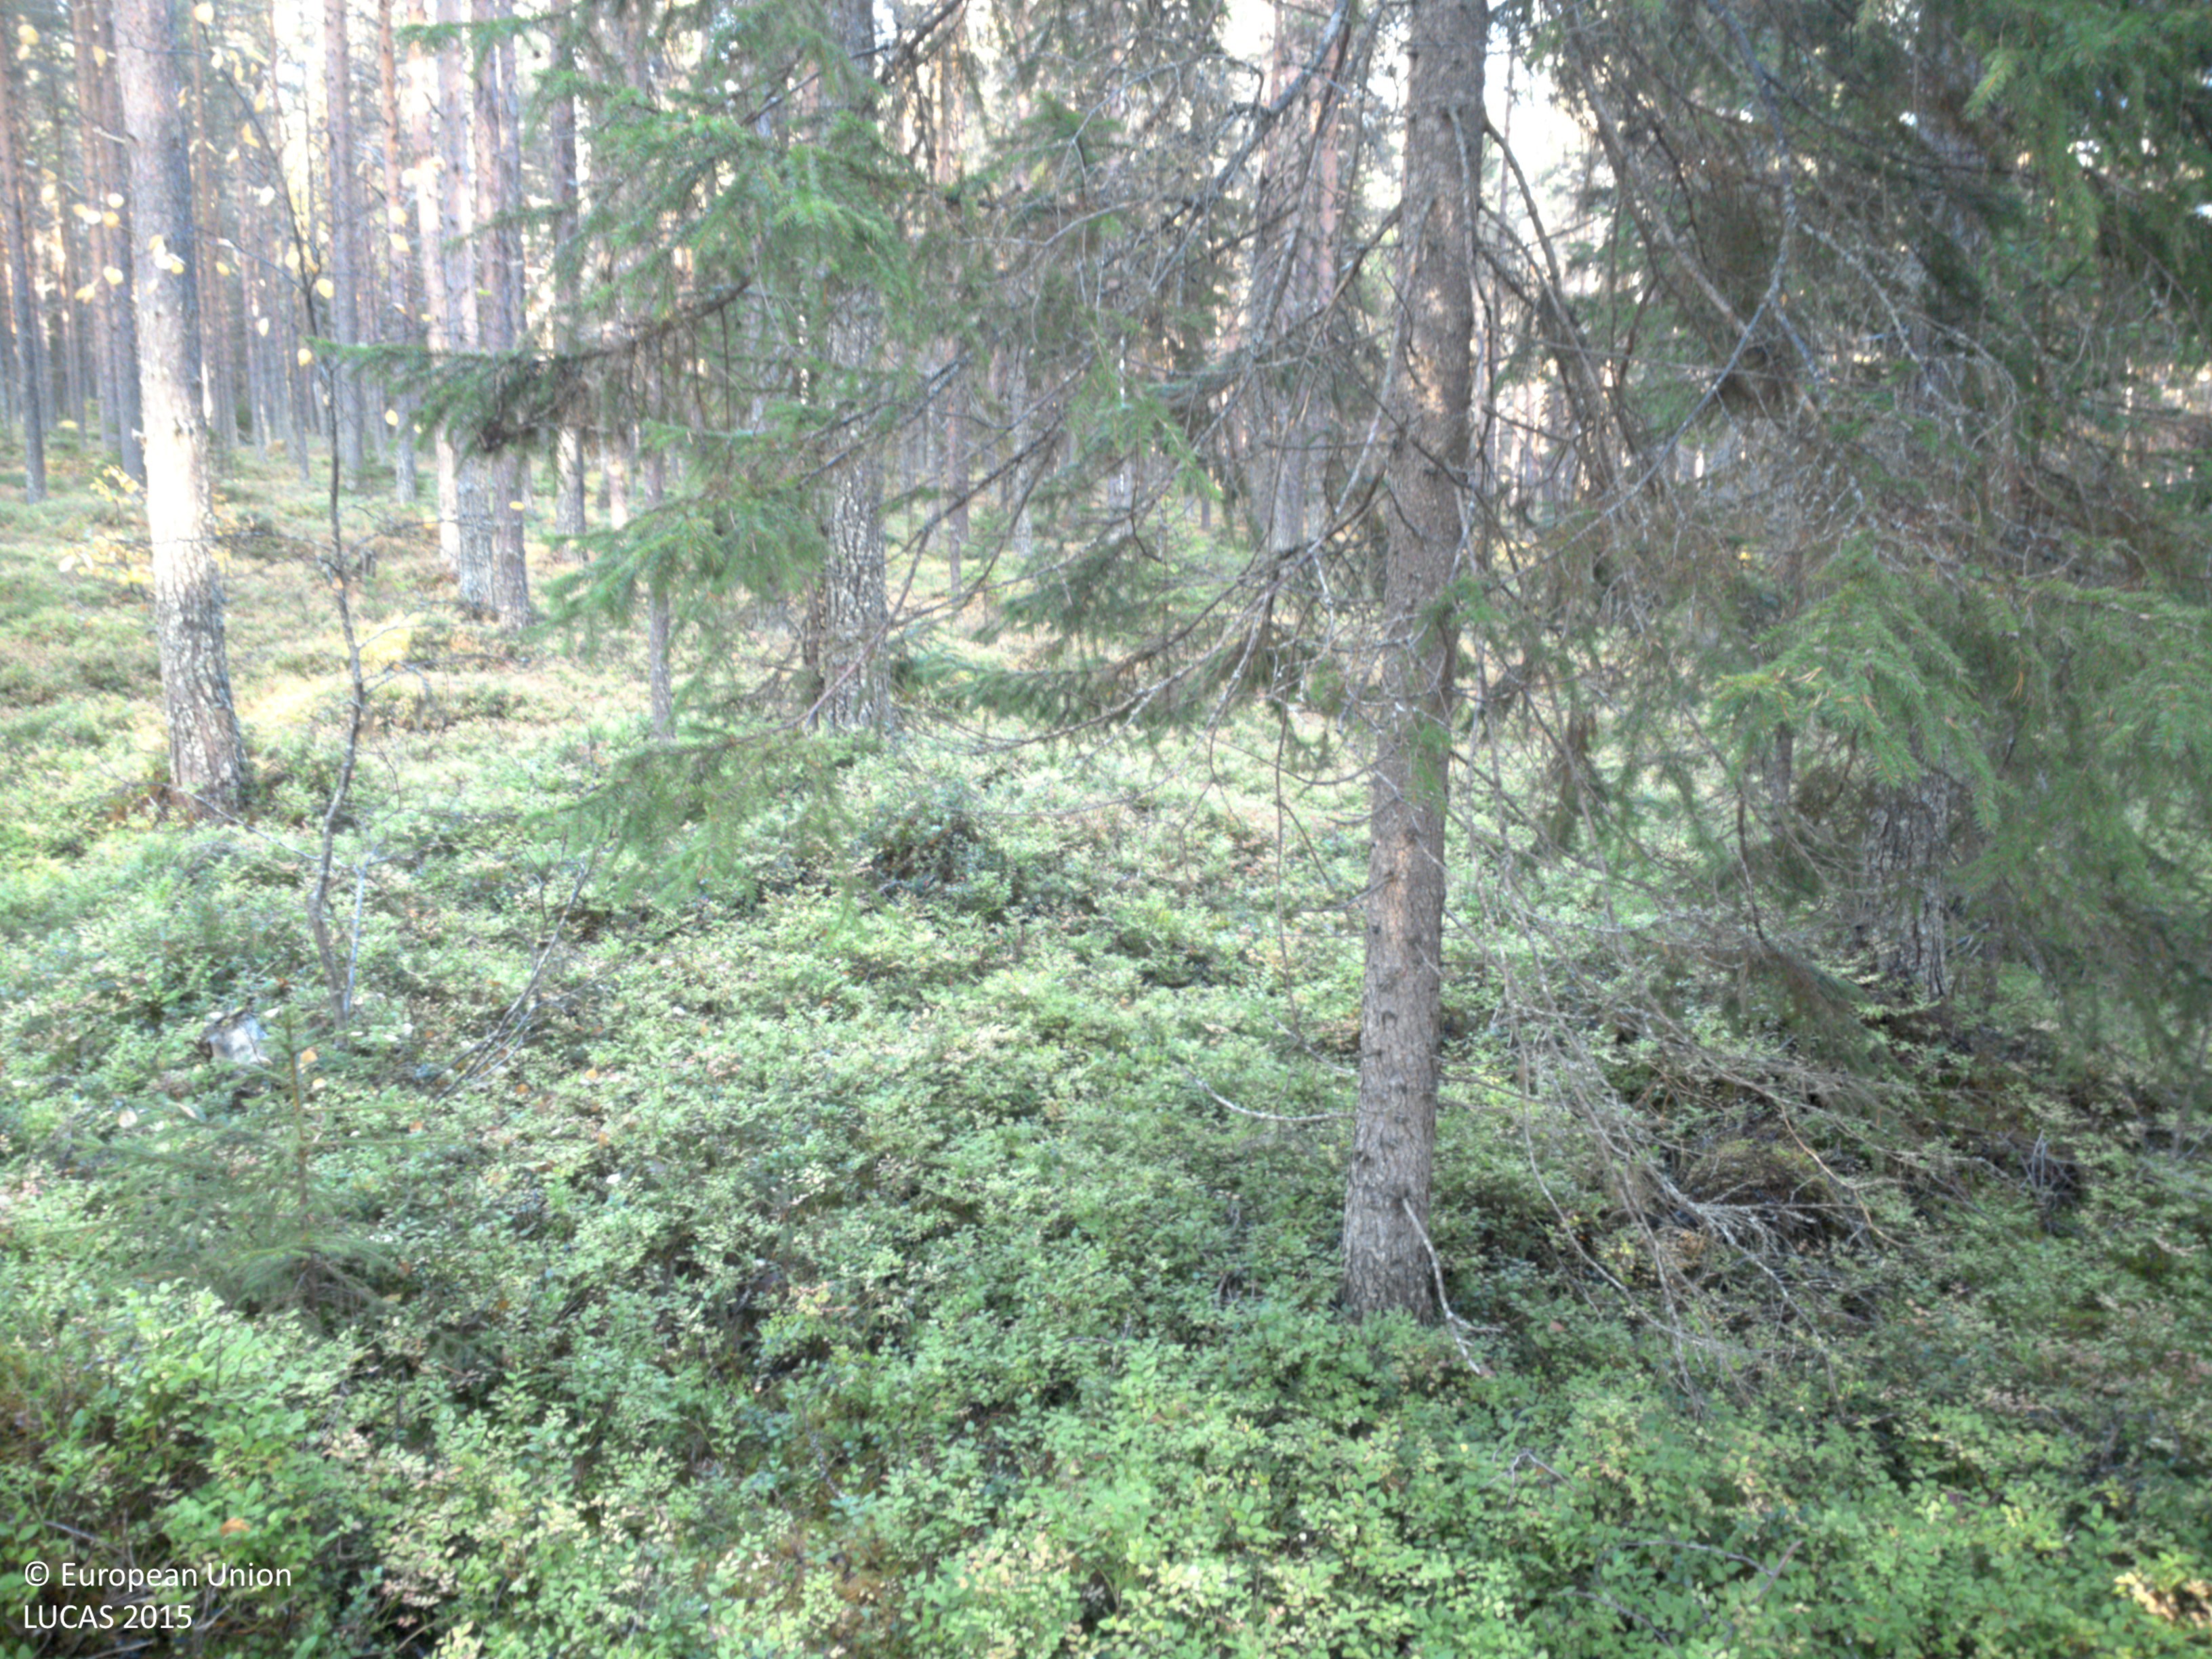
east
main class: Woodland
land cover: Other coniferous woodland
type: boreal forest
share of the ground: > 75 %
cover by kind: coniferous forest trees 70 %, shrubs 25 %, broadleaved forest trees 5 %
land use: Forestry
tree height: > 5 m
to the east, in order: Other coniferous woodland; Pine dominated coniferous woodland; Electric lines; Pine dominated coniferous woodland; Tracks; Other coniferous woodland; Ditches and canals; Other mixed woodland; Pine dominated coniferous woodland
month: September
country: SE
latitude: 64.8109
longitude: 19.0854
